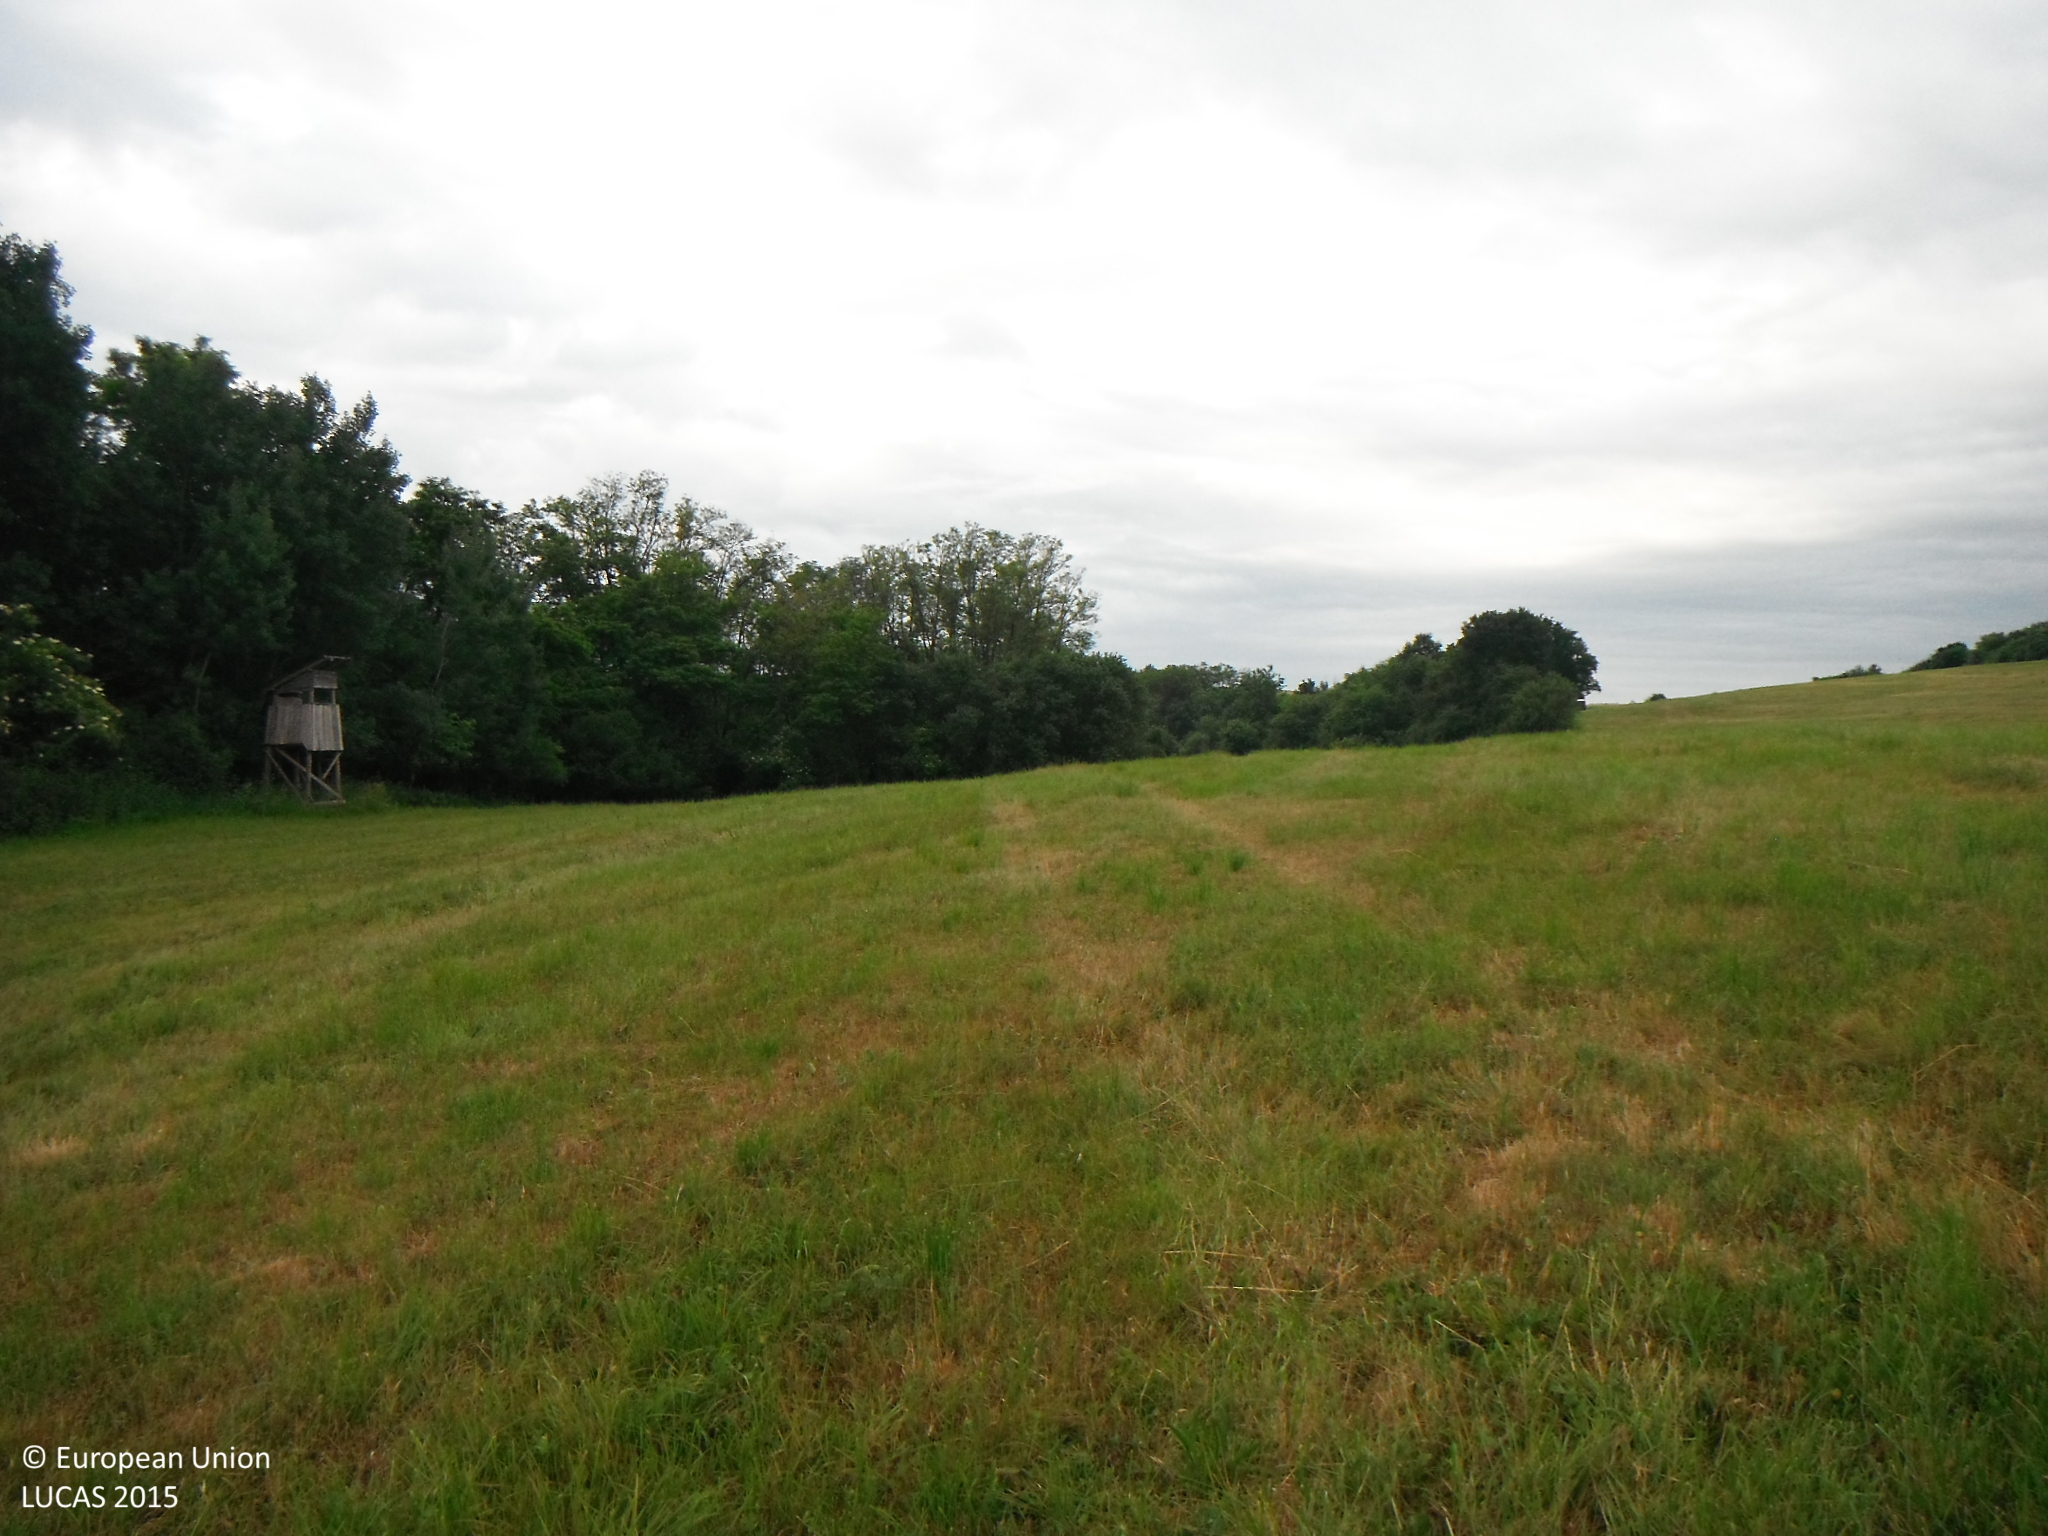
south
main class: Grassland
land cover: Grassland without tree/shrub cover
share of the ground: > 75 %
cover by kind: herbaceous plants 100 %
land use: Agriculture (excluding fallow land and kitchen gardens)
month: June
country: SK
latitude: 48.3308
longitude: 19.3710
